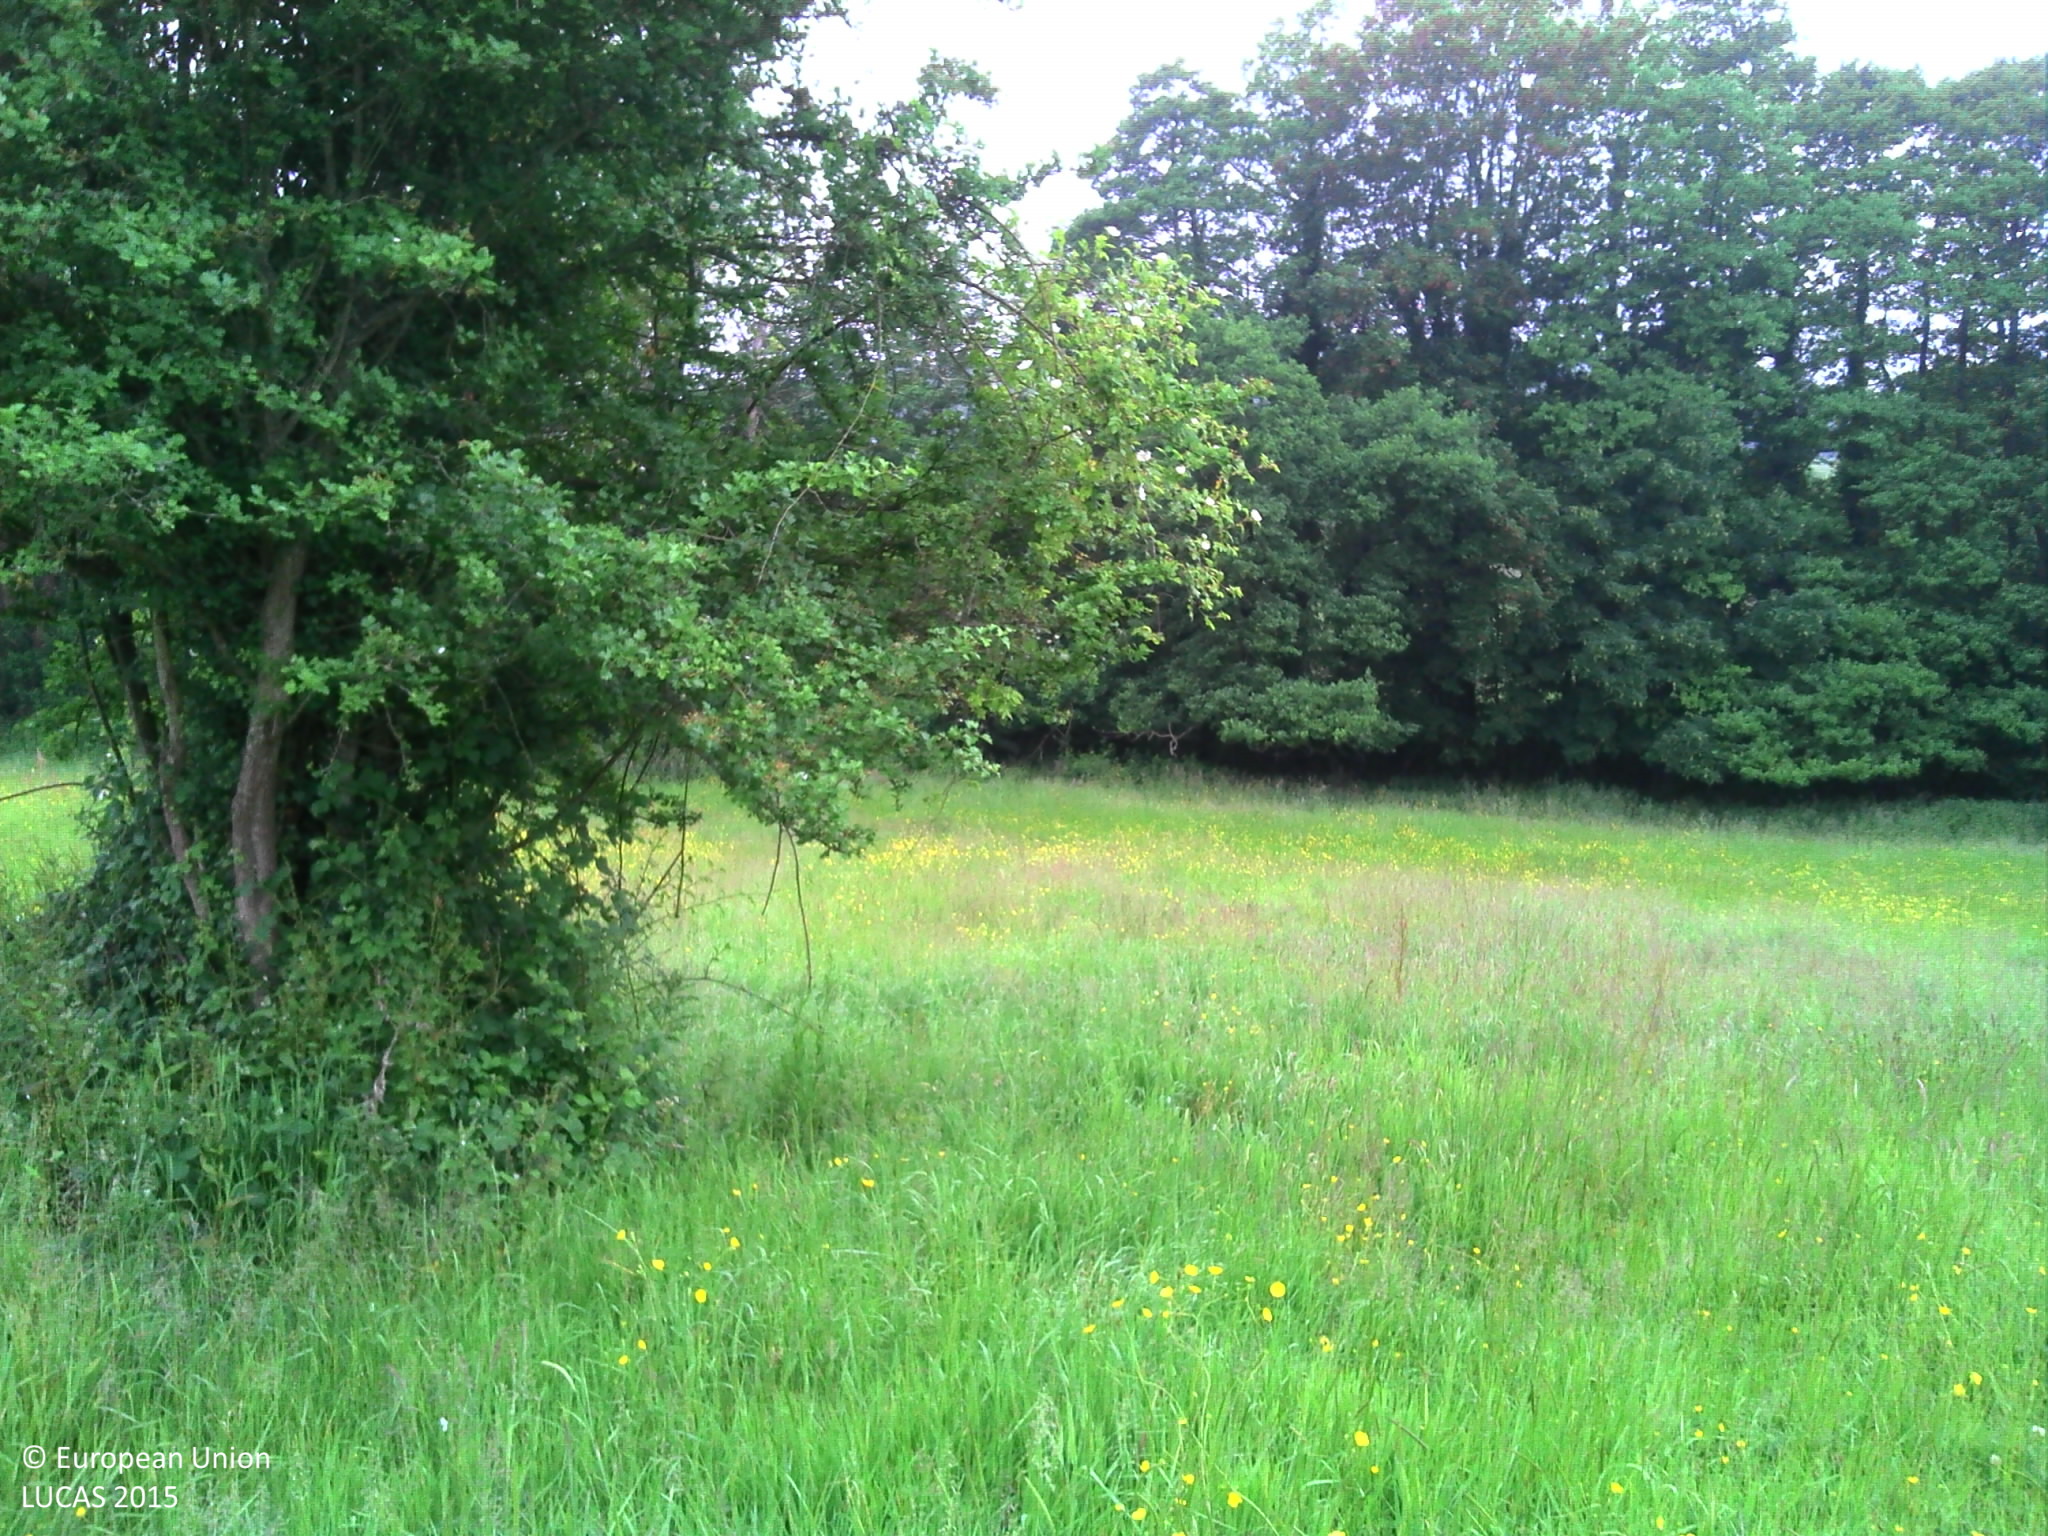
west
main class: Grassland
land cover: Grassland without tree/shrub cover
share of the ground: > 75 %
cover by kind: herbaceous plants 100 %
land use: Agriculture (excluding fallow land and kitchen gardens)
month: June
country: FR
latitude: 49.2549
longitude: 0.0079
